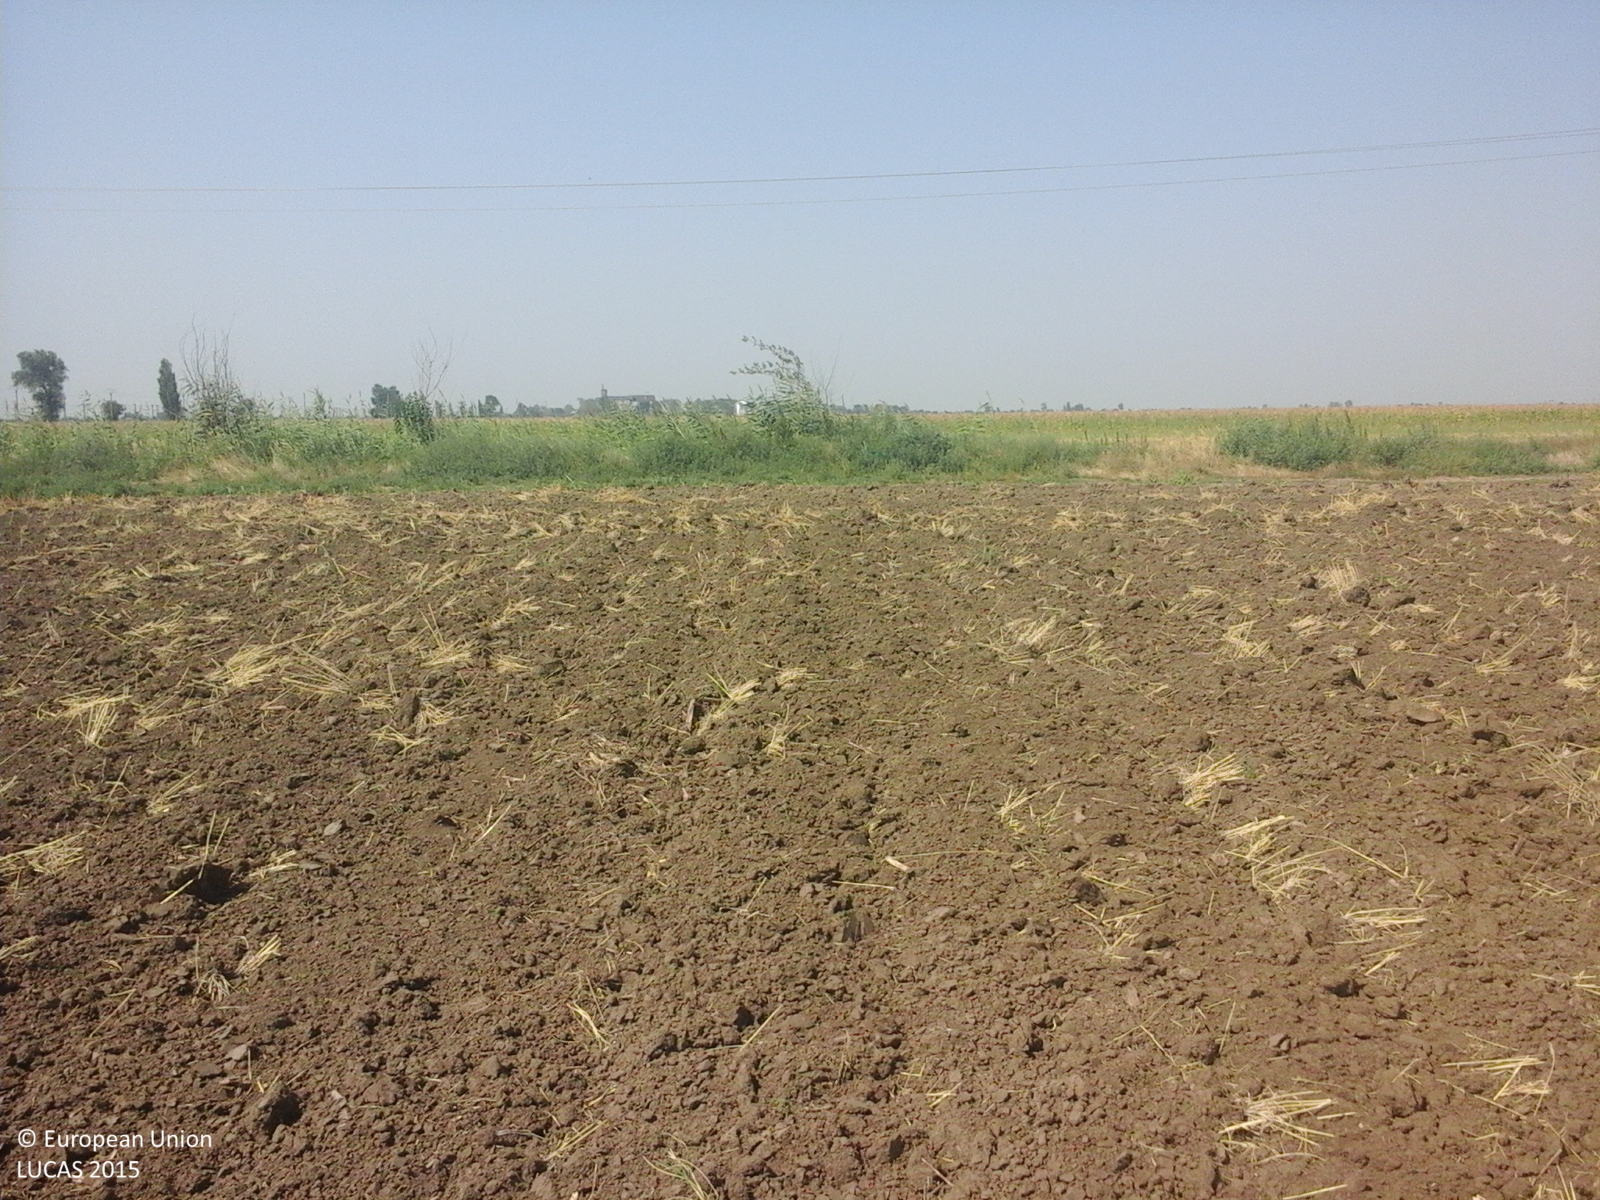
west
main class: Cropland
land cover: Common wheat
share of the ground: < 10 %
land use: Agriculture (excluding fallow land and kitchen gardens)
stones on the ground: < 10 %
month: August
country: RO
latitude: 45.0917
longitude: 27.3098
